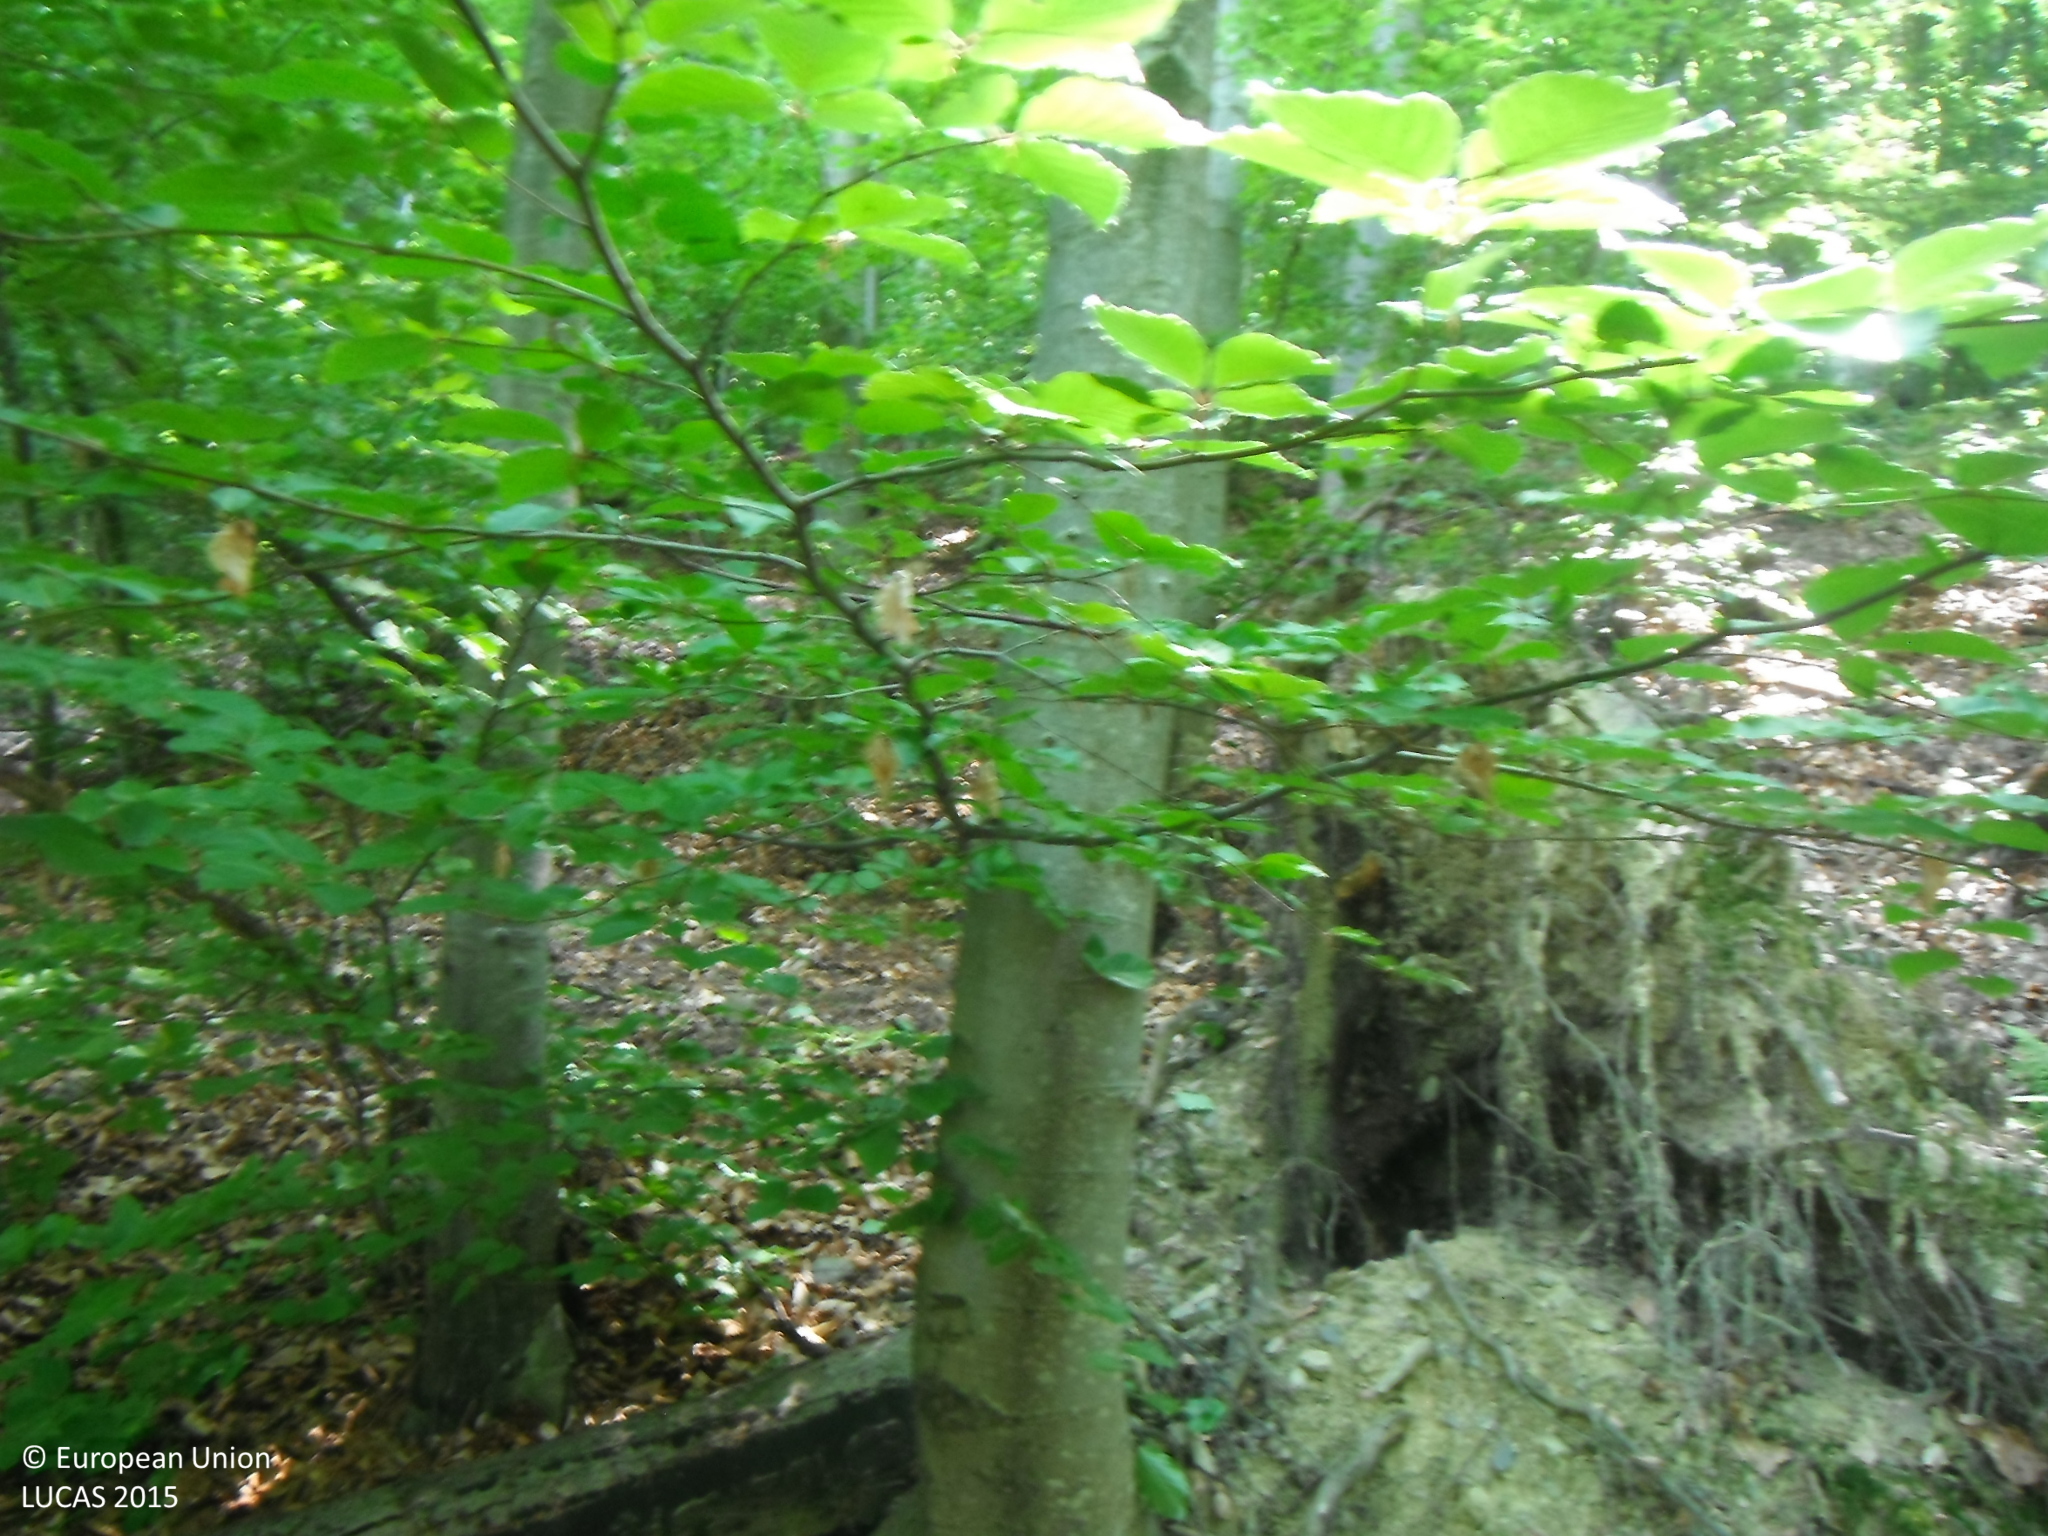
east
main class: Woodland
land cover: Broadleaved woodland
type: beech forest
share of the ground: > 75 %
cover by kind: broadleaved forest trees 100 %
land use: Forestry
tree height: > 5 m
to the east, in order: Broadleaved woodland; Tracks; Broadleaved woodland
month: July
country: SK
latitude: 48.9972
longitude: 22.3762
